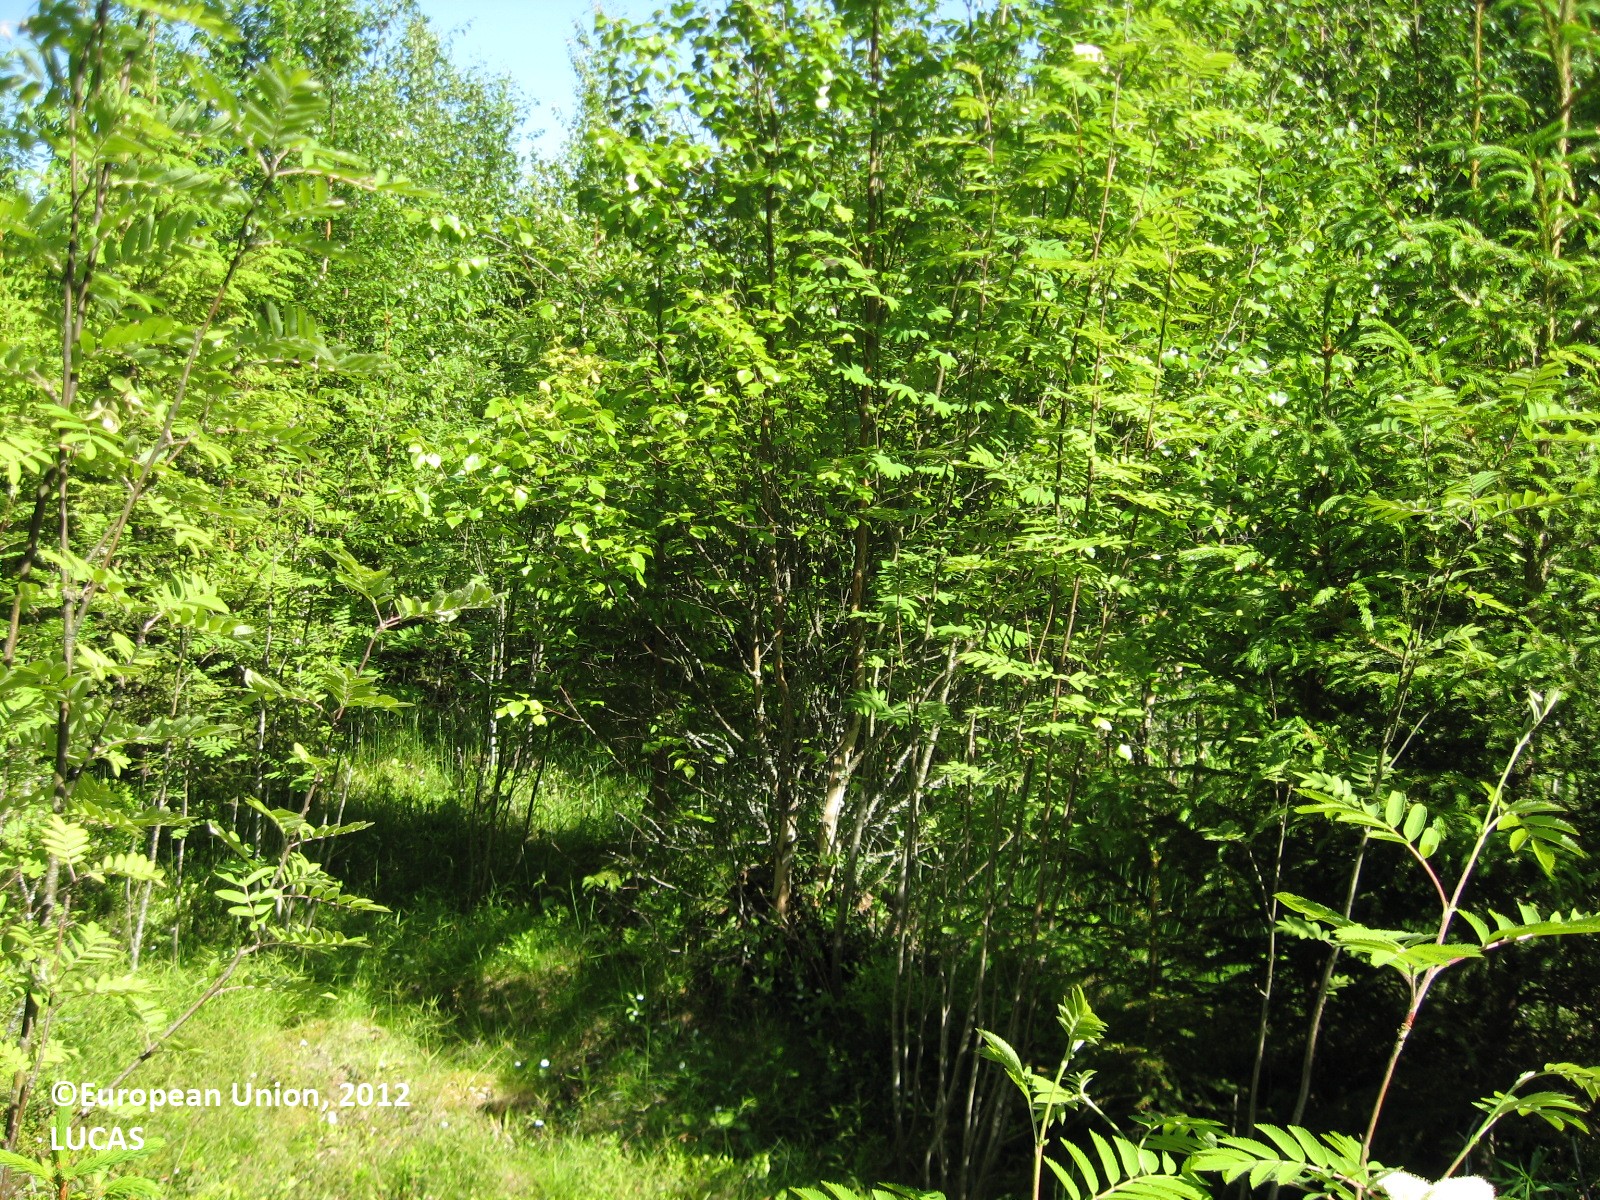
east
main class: Woodland
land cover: Spruce dominated mixed woodland
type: boreal forest
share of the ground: > 75 %
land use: Forestry
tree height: > 5 m
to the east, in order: Spruce dominated mixed woodland; Broadleaved woodland; Spruce dominated coniferous woodland; Ditches and canals; Spruce dominated mixed woodland; Barley; Shruby margins; Ditches and canals; Shruby margins; Oats
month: June
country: FI
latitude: 62.9913
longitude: 21.7468
